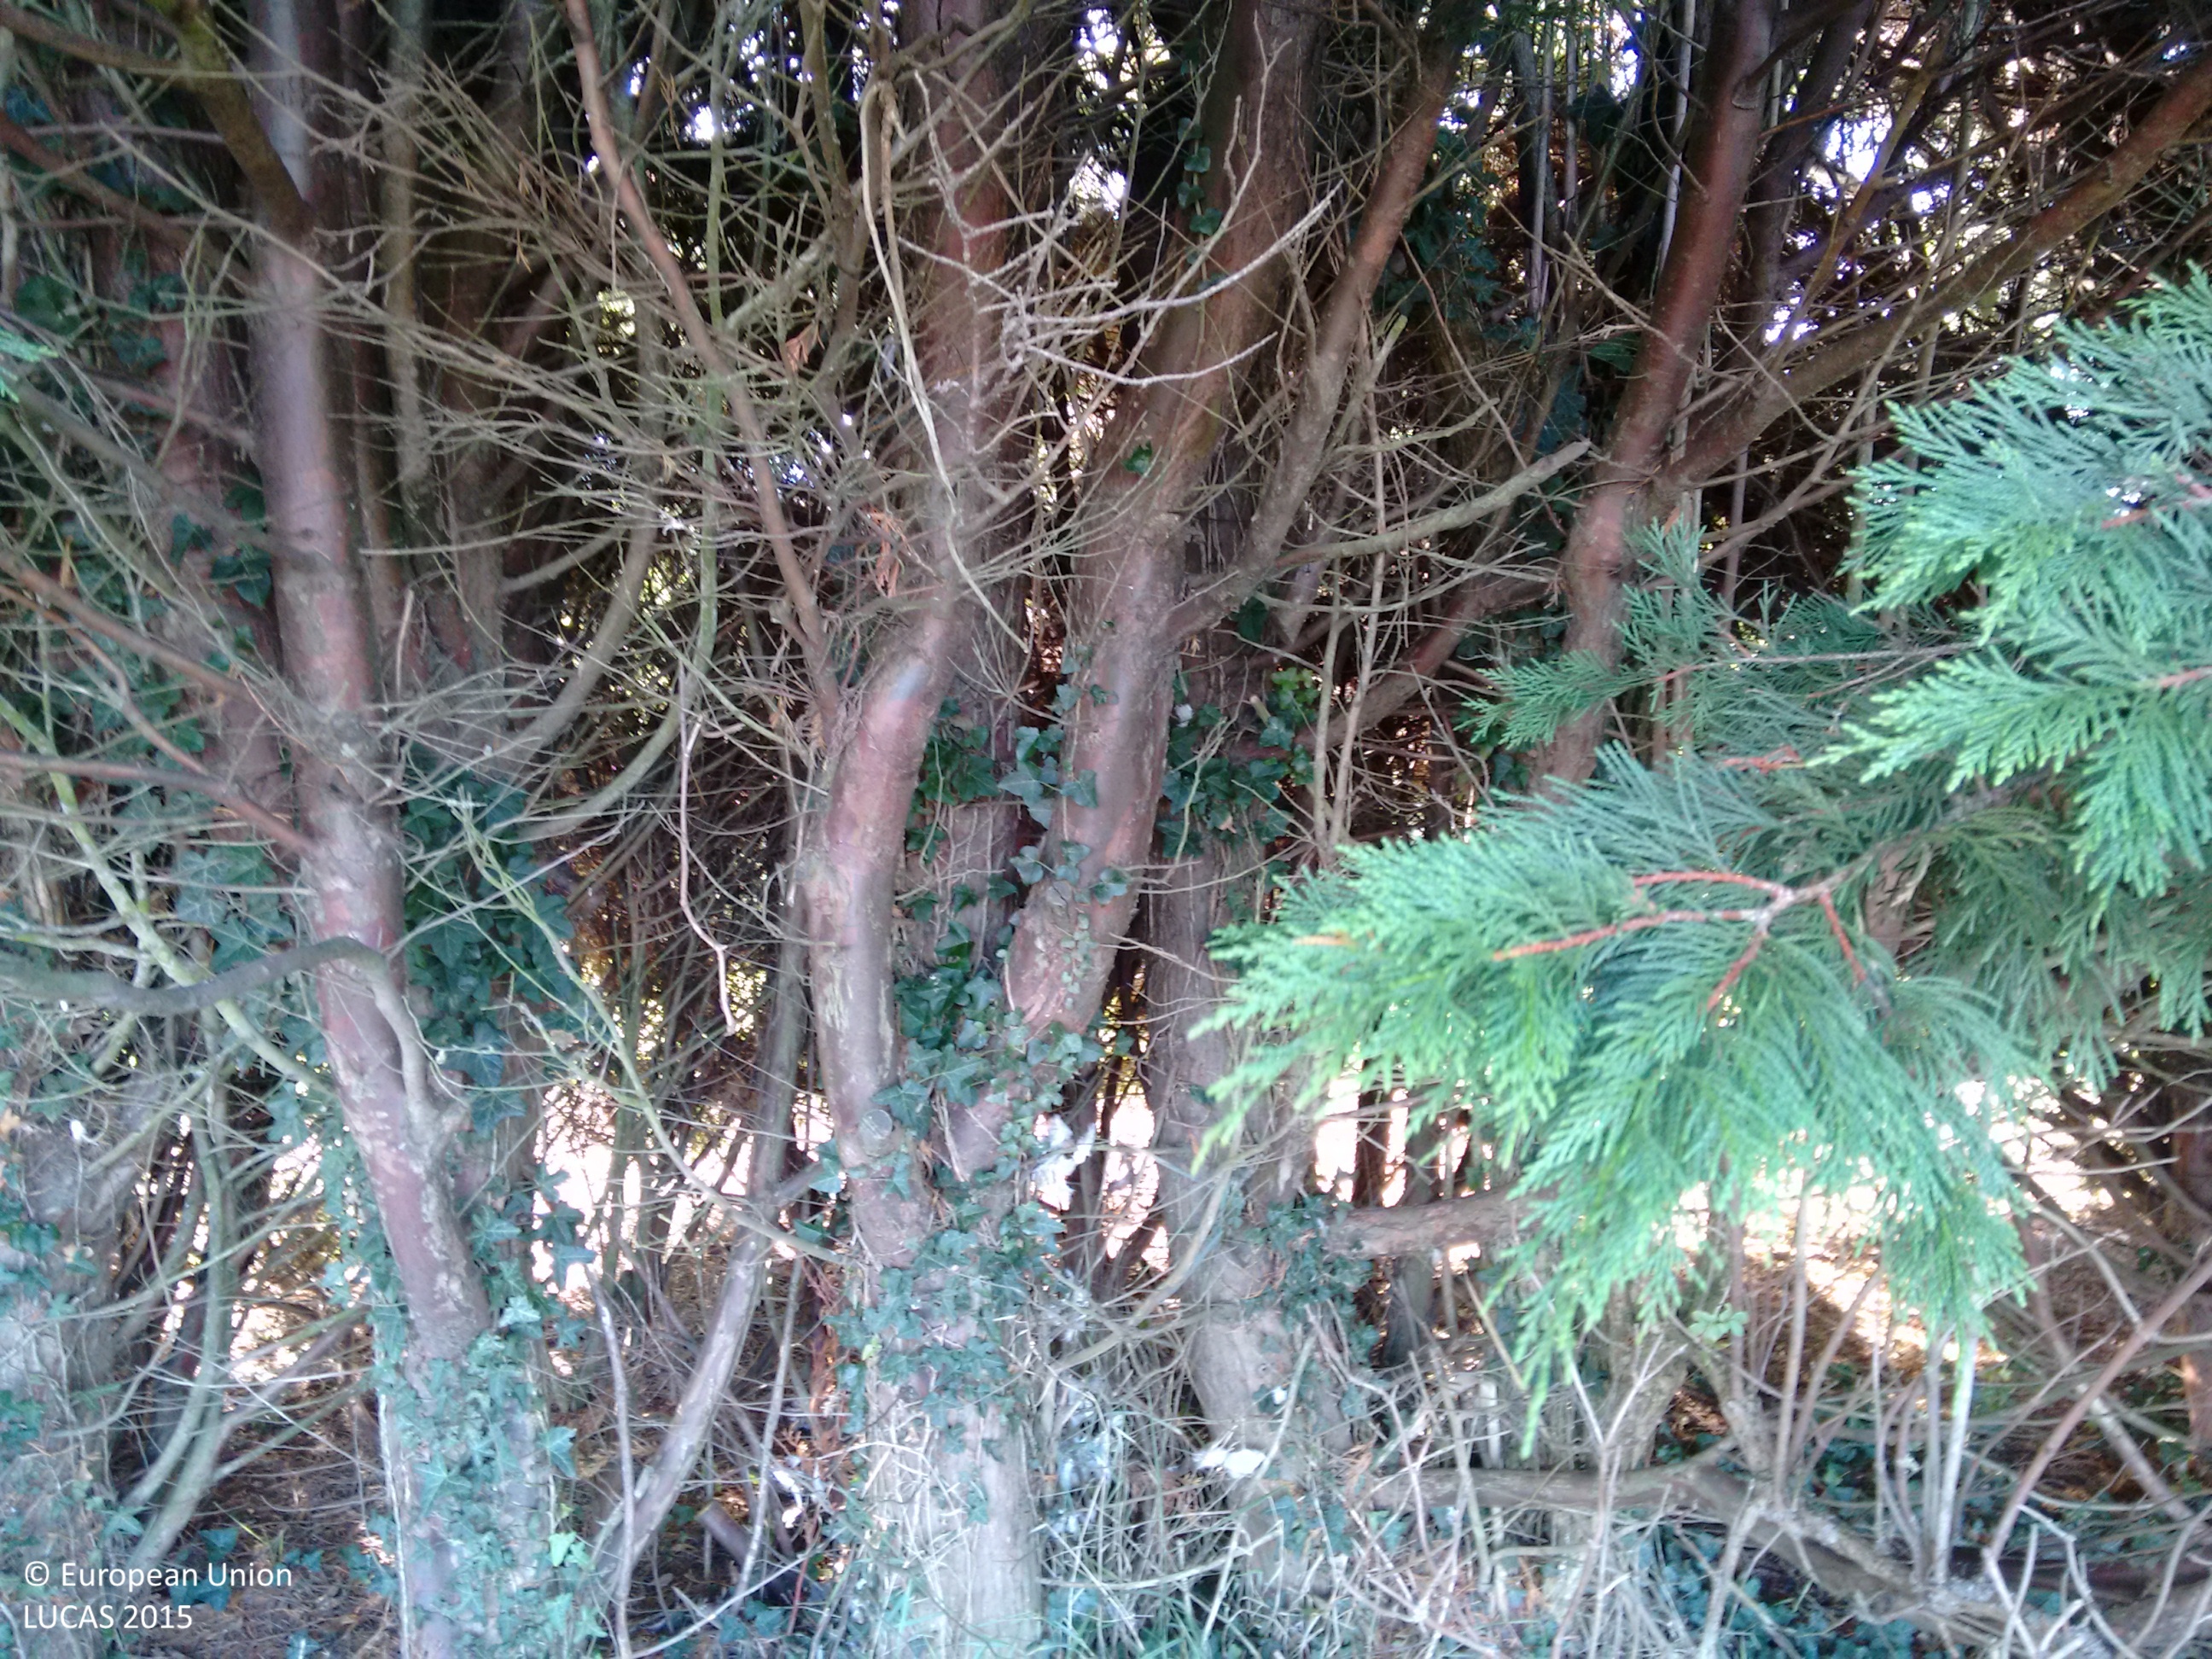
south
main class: Cropland
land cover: Common wheat
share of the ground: > 75 %
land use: Agriculture (excluding fallow land and kitchen gardens)
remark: Harvested field
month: October
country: GB
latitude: 52.6997
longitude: 1.6807
